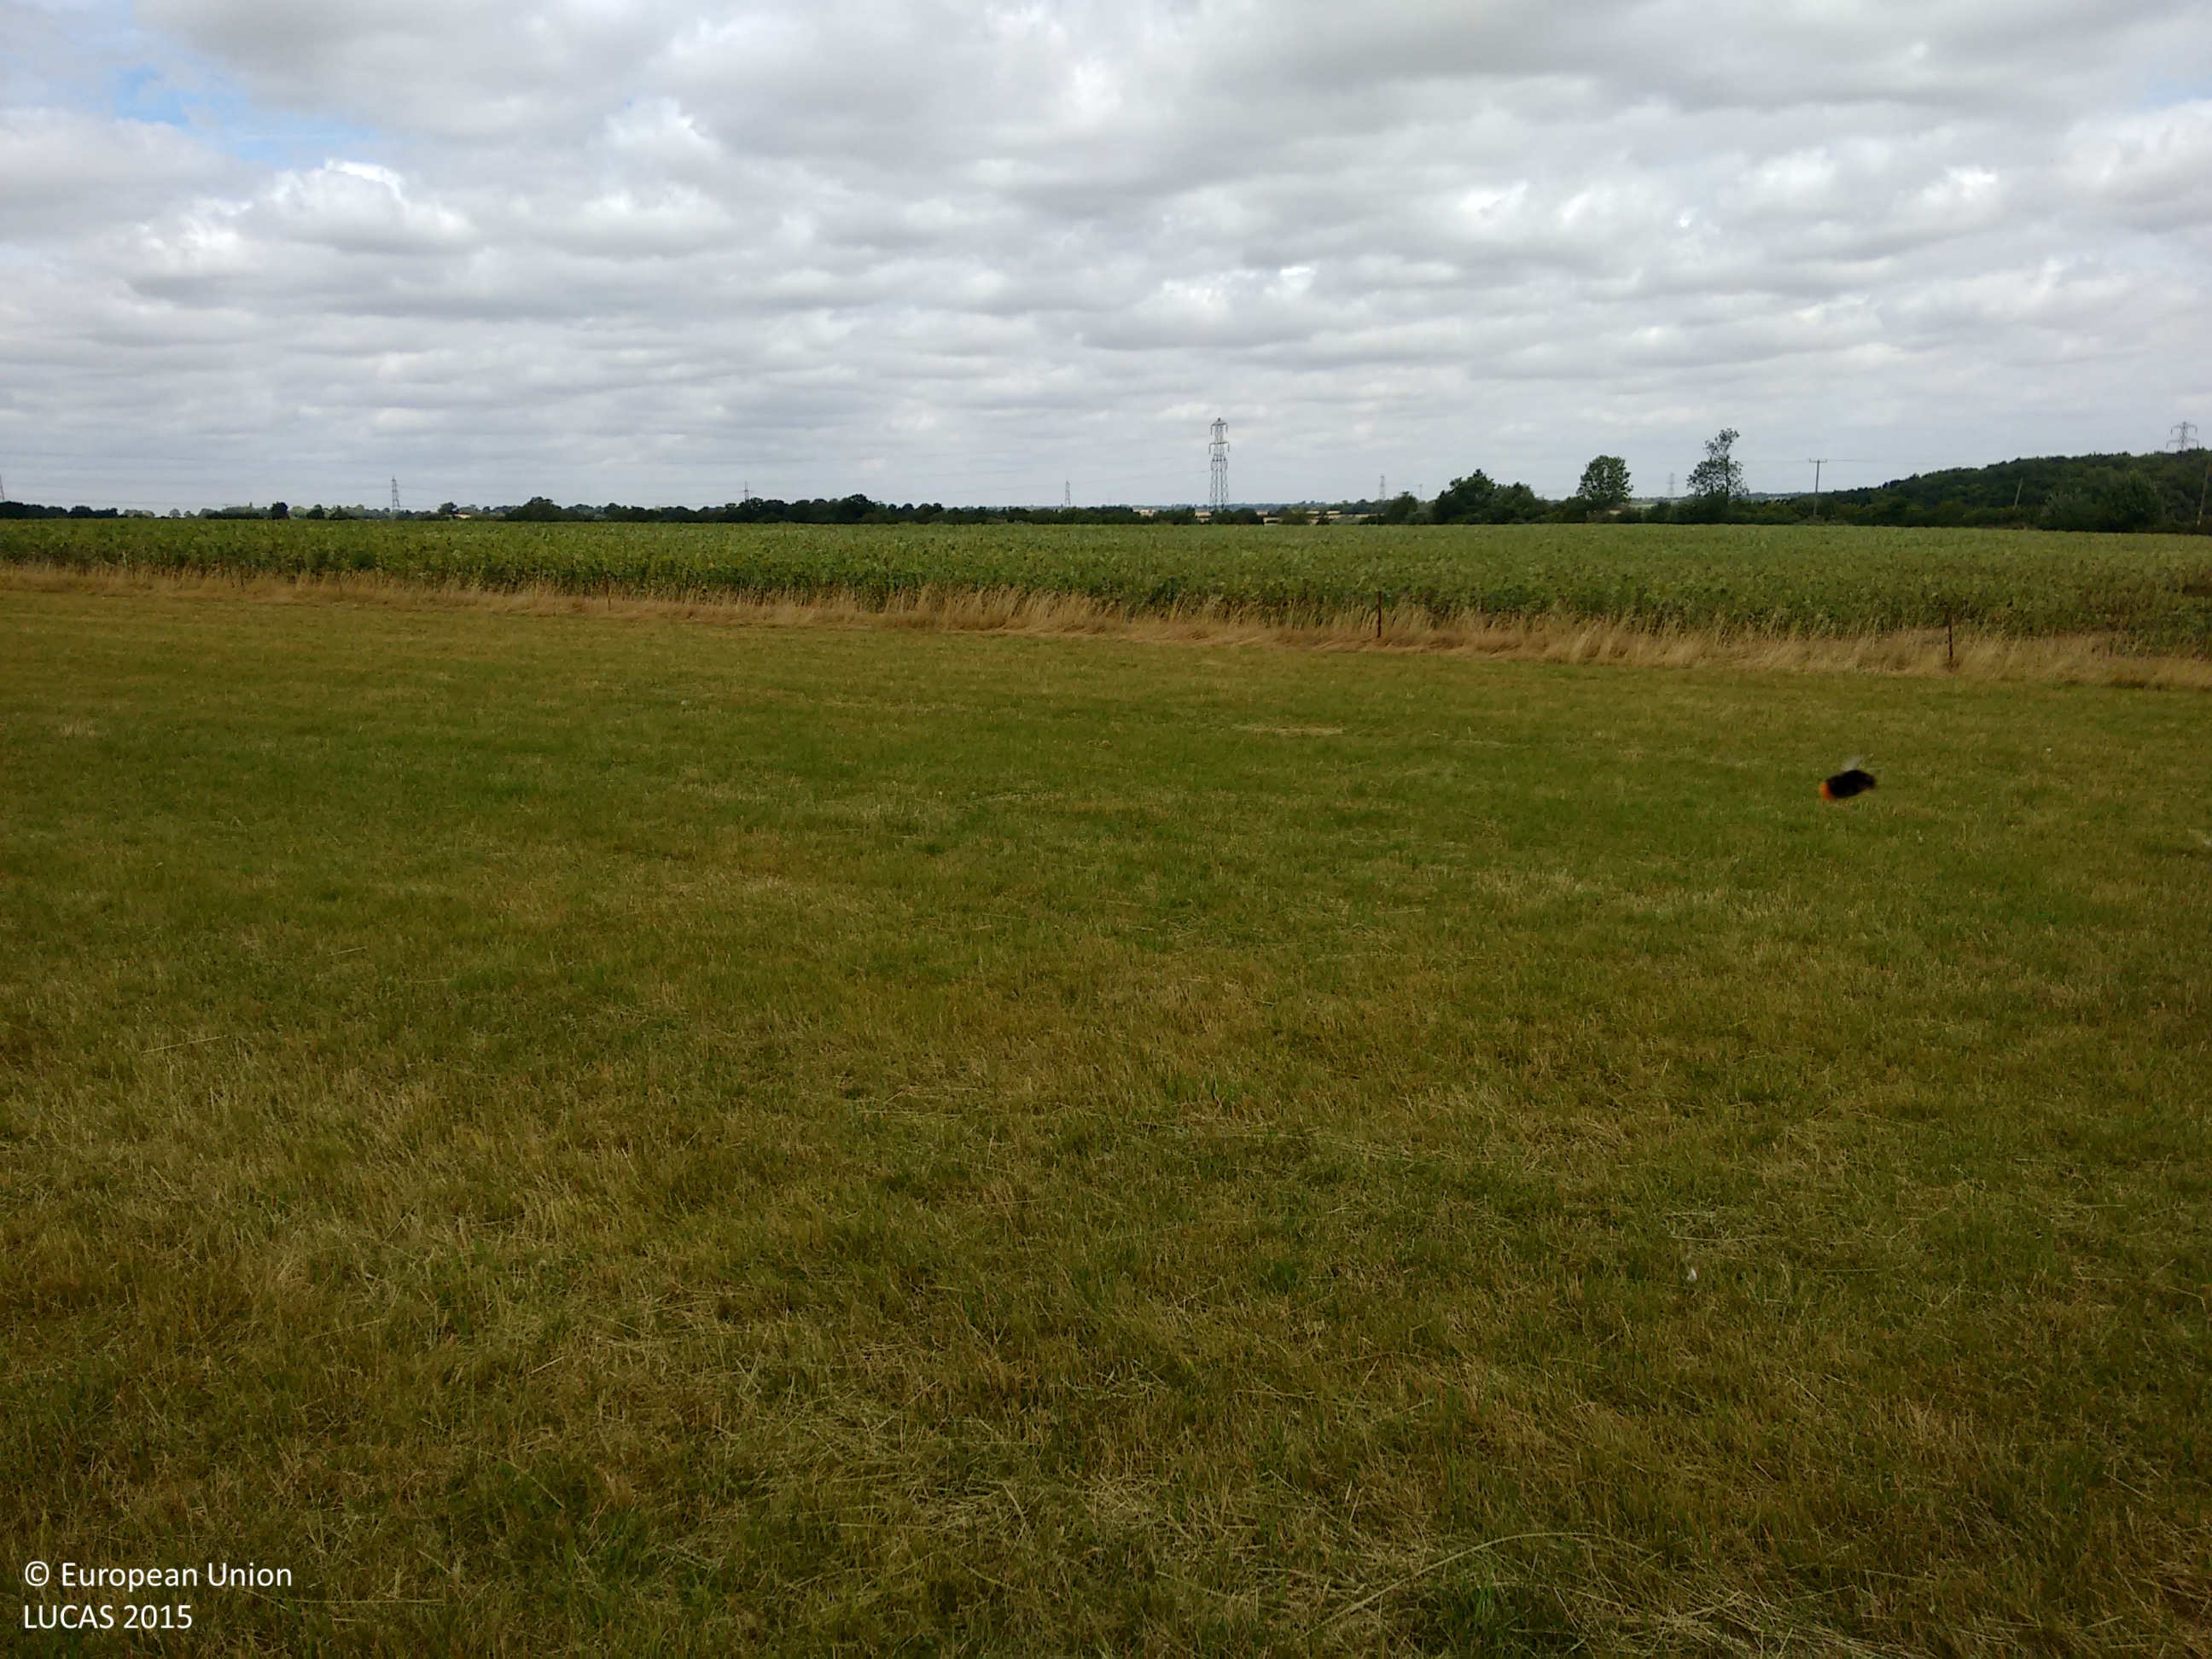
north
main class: Grassland
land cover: Grassland without tree/shrub cover
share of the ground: > 75 %
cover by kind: herbaceous plants 100 %
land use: Agriculture (excluding fallow land and kitchen gardens)
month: August
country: GB
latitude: 51.9678
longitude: 0.3791
